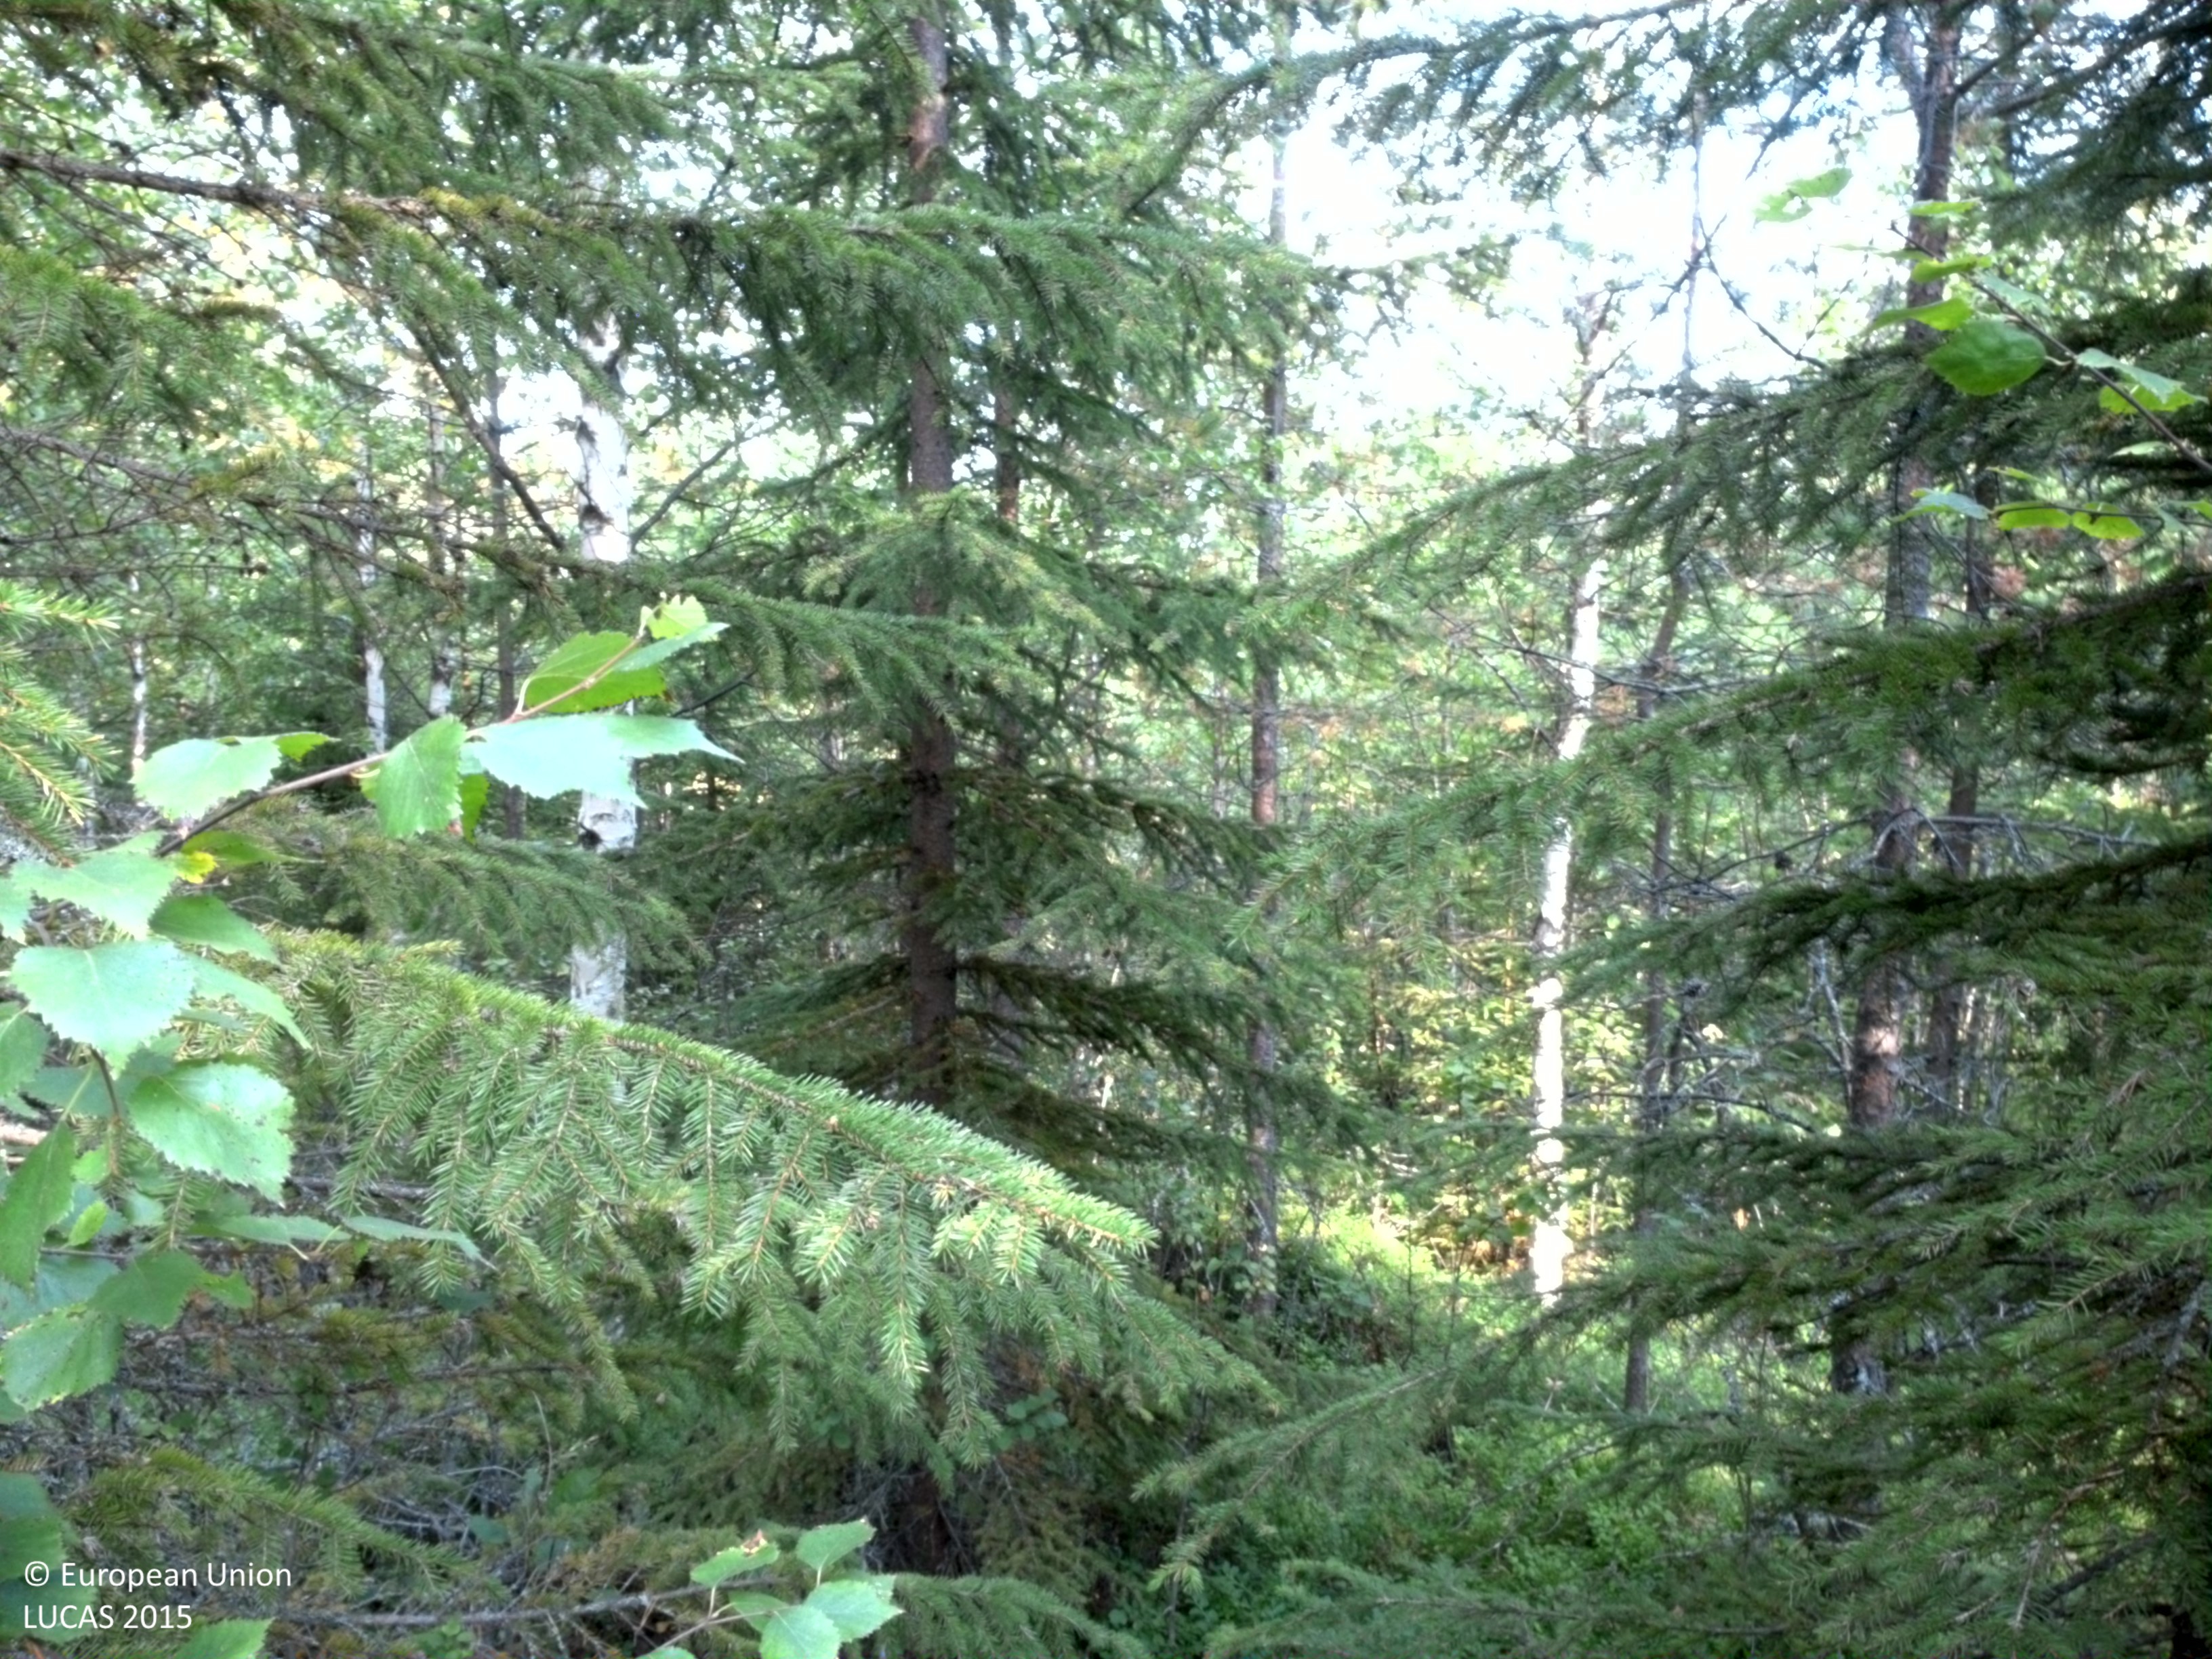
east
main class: Woodland
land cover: Pine dominated mixed woodland
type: boreal forest
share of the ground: 50 - 75 %
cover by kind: coniferous forest trees 45 %, shrubs 40 %, broadleaved forest trees 15 %
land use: Forestry
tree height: > 5 m
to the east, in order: Pine dominated mixed woodland; Spruce dominated mixed woodland; Ditches and canals; Spruce dominated mixed woodland; Ditches and canals; Pine dominated mixed woodland; Ditches and canals; Pine dominated mixed woodland
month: August
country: SE
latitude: 64.4401
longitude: 18.8815
